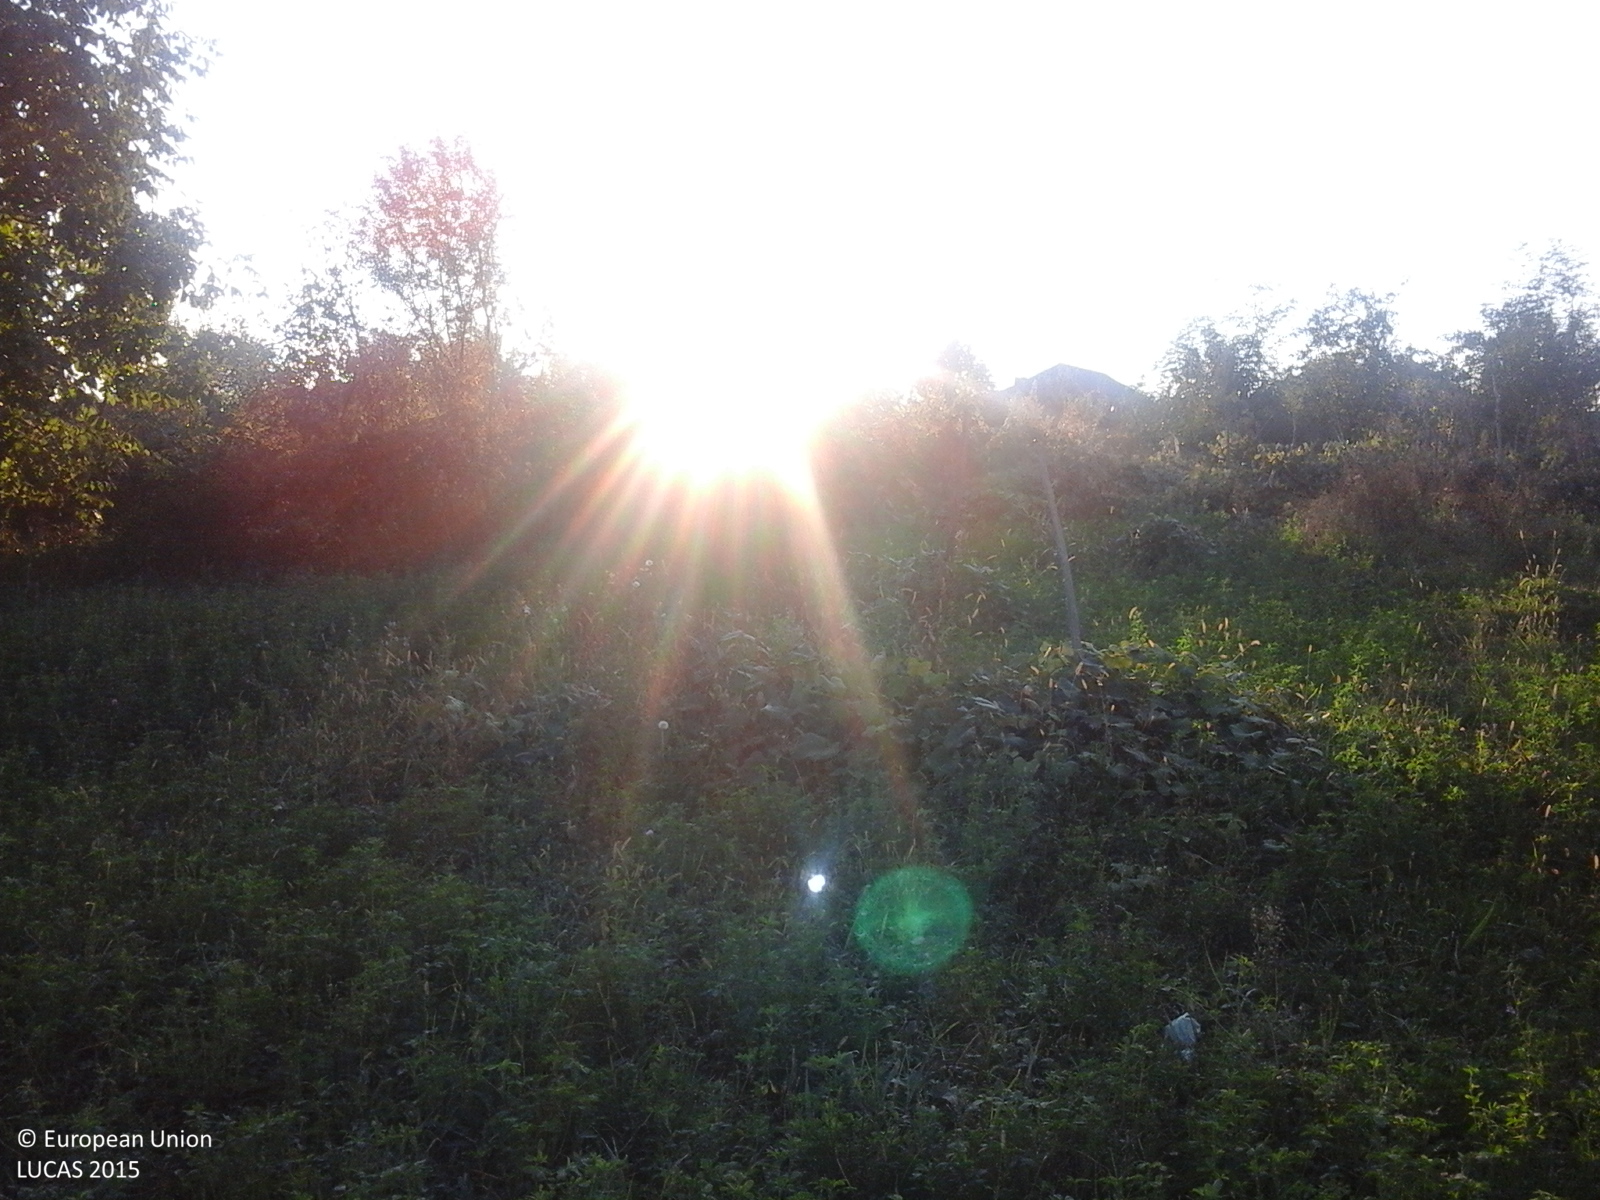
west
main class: Cropland
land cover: Lucerne
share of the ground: > 75 %
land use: Agriculture (excluding fallow land and kitchen gardens)
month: September
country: RO
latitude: 45.0213
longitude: 23.6000
